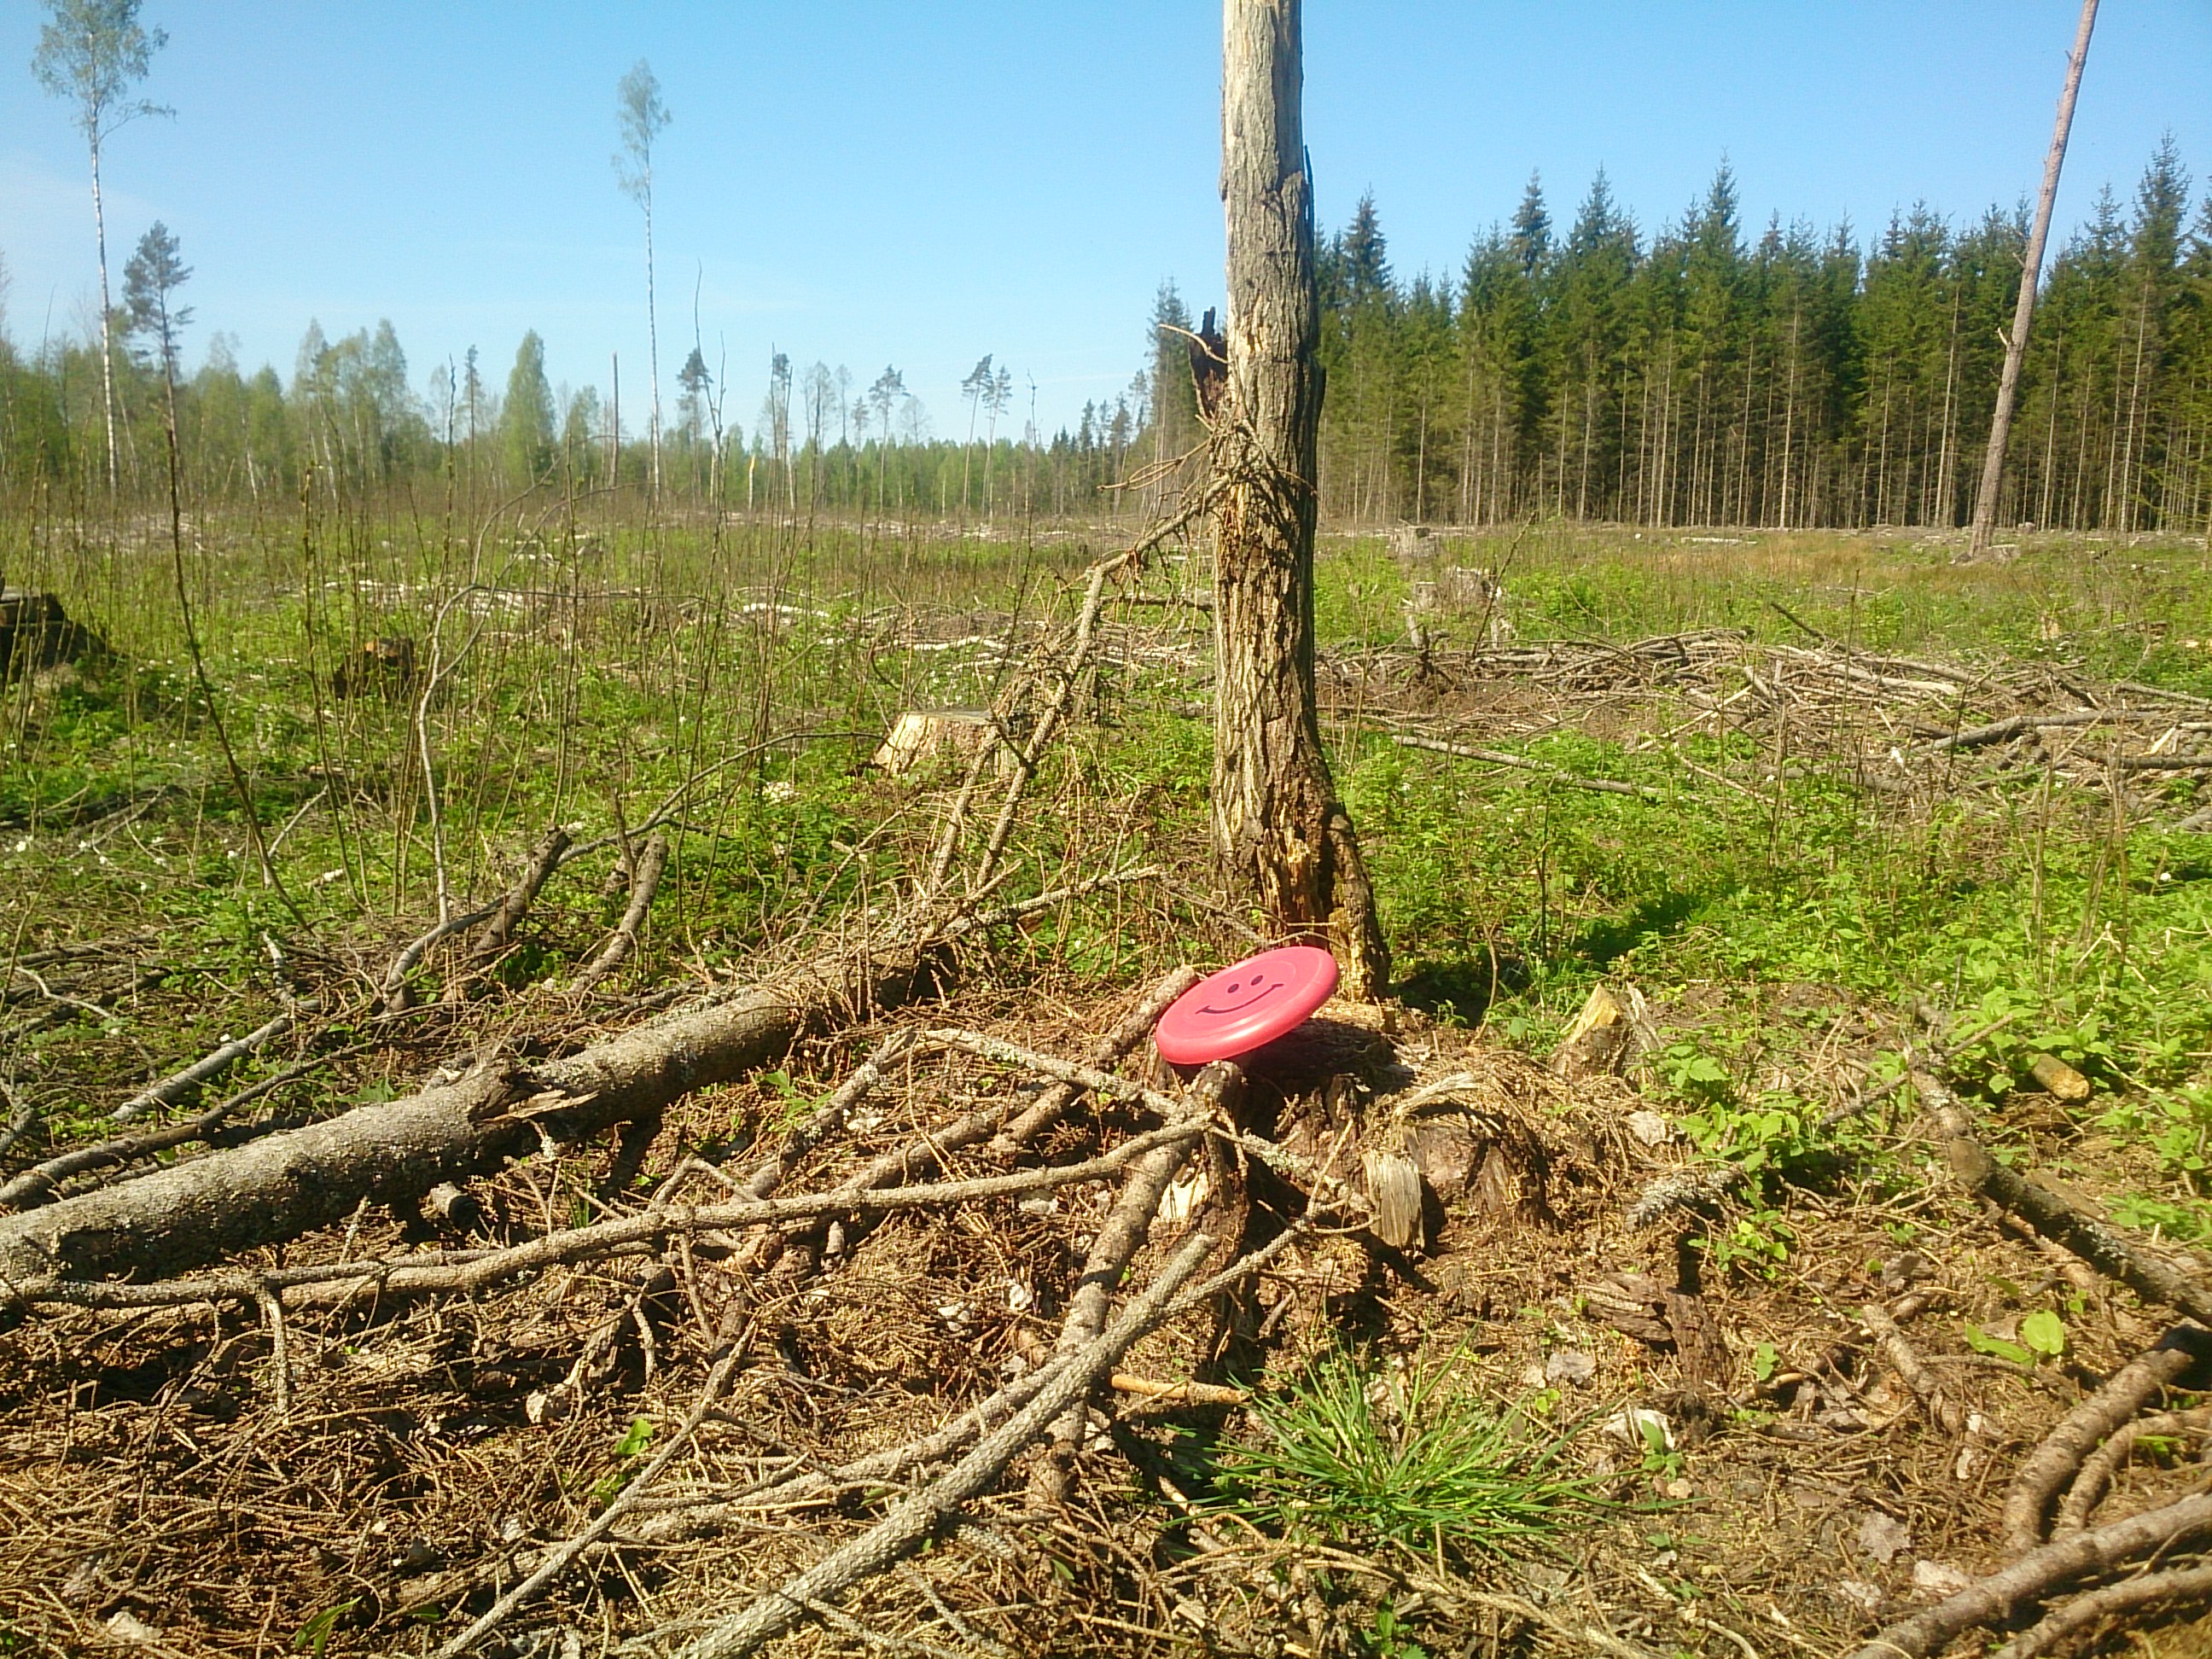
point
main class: Shrubland
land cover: Shrubland with sparse tree cover
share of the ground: 50 - 75 %
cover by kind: shrubs 55 %, herbaceous plants 30 %, unconsolidated bare surface 10 %, coniferous forest trees 5 %
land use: Forestry
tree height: > 5 m
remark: Clear cut
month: May
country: LV
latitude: 56.6861
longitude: 24.4105
